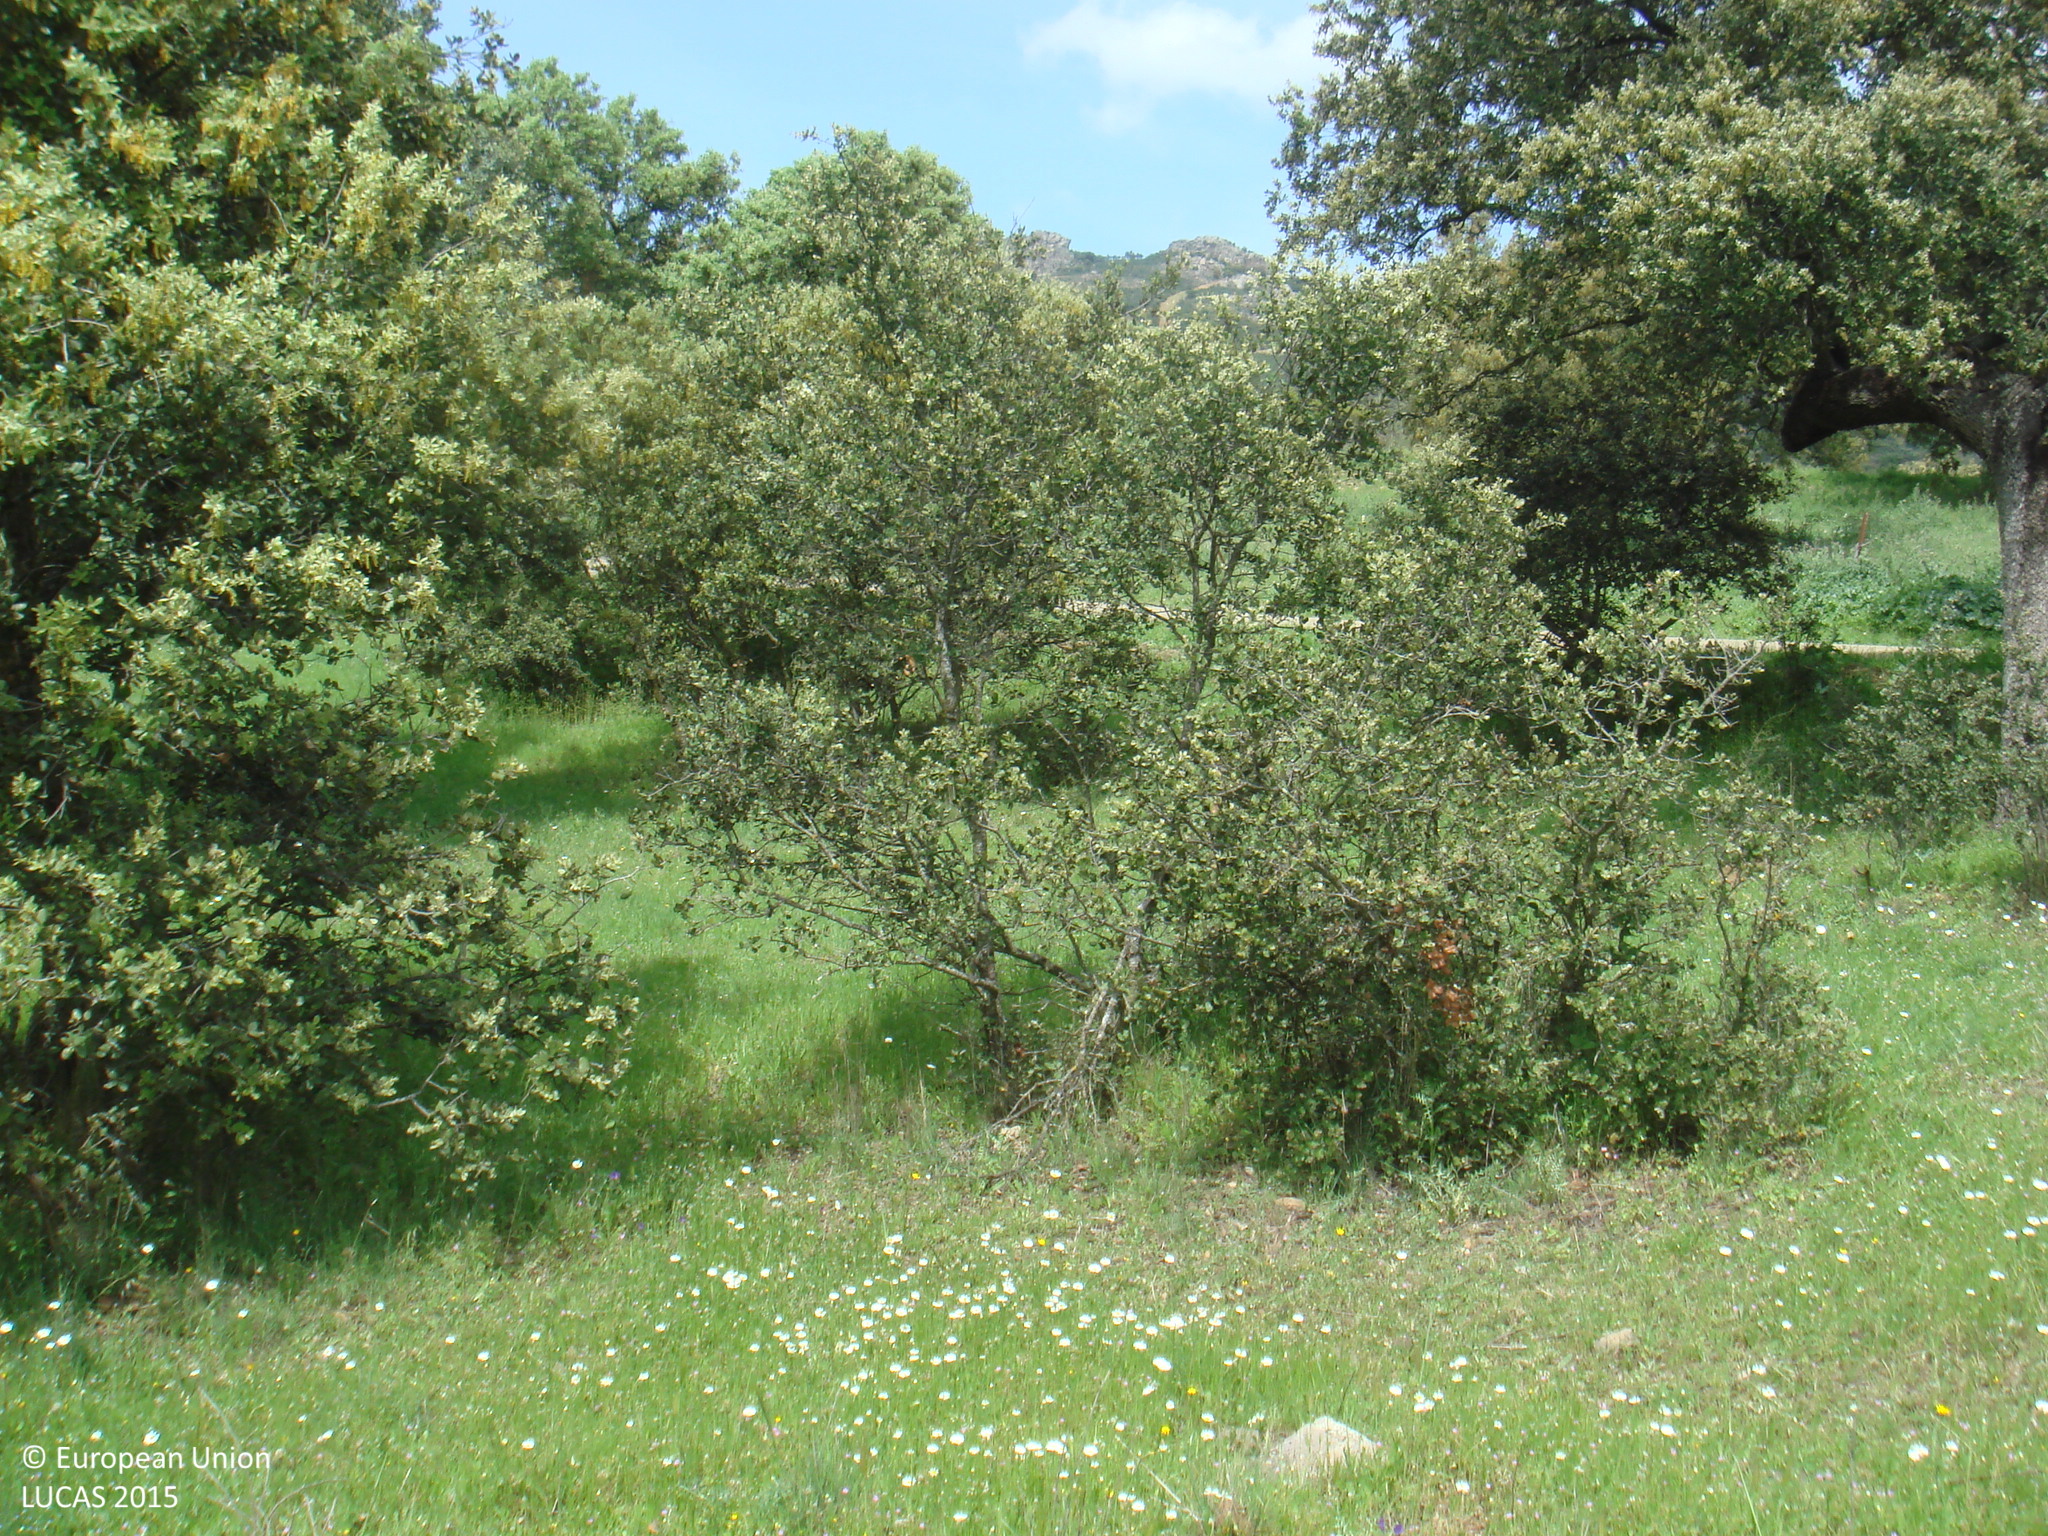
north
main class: Woodland
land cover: Broadleaved woodland
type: broadleaved evergreen forest
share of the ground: 25 - 50 %
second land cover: Grassland without tree/shrub cover
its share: 50 - 75 %
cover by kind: herbaceous plants 55 %, broadleaved forest trees 40 %, shrubs 5 %
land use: Forestry
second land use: Agriculture (excluding fallow land and kitchen gardens)
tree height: > 5 m
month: April
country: ES
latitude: 38.2497
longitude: -5.0738
